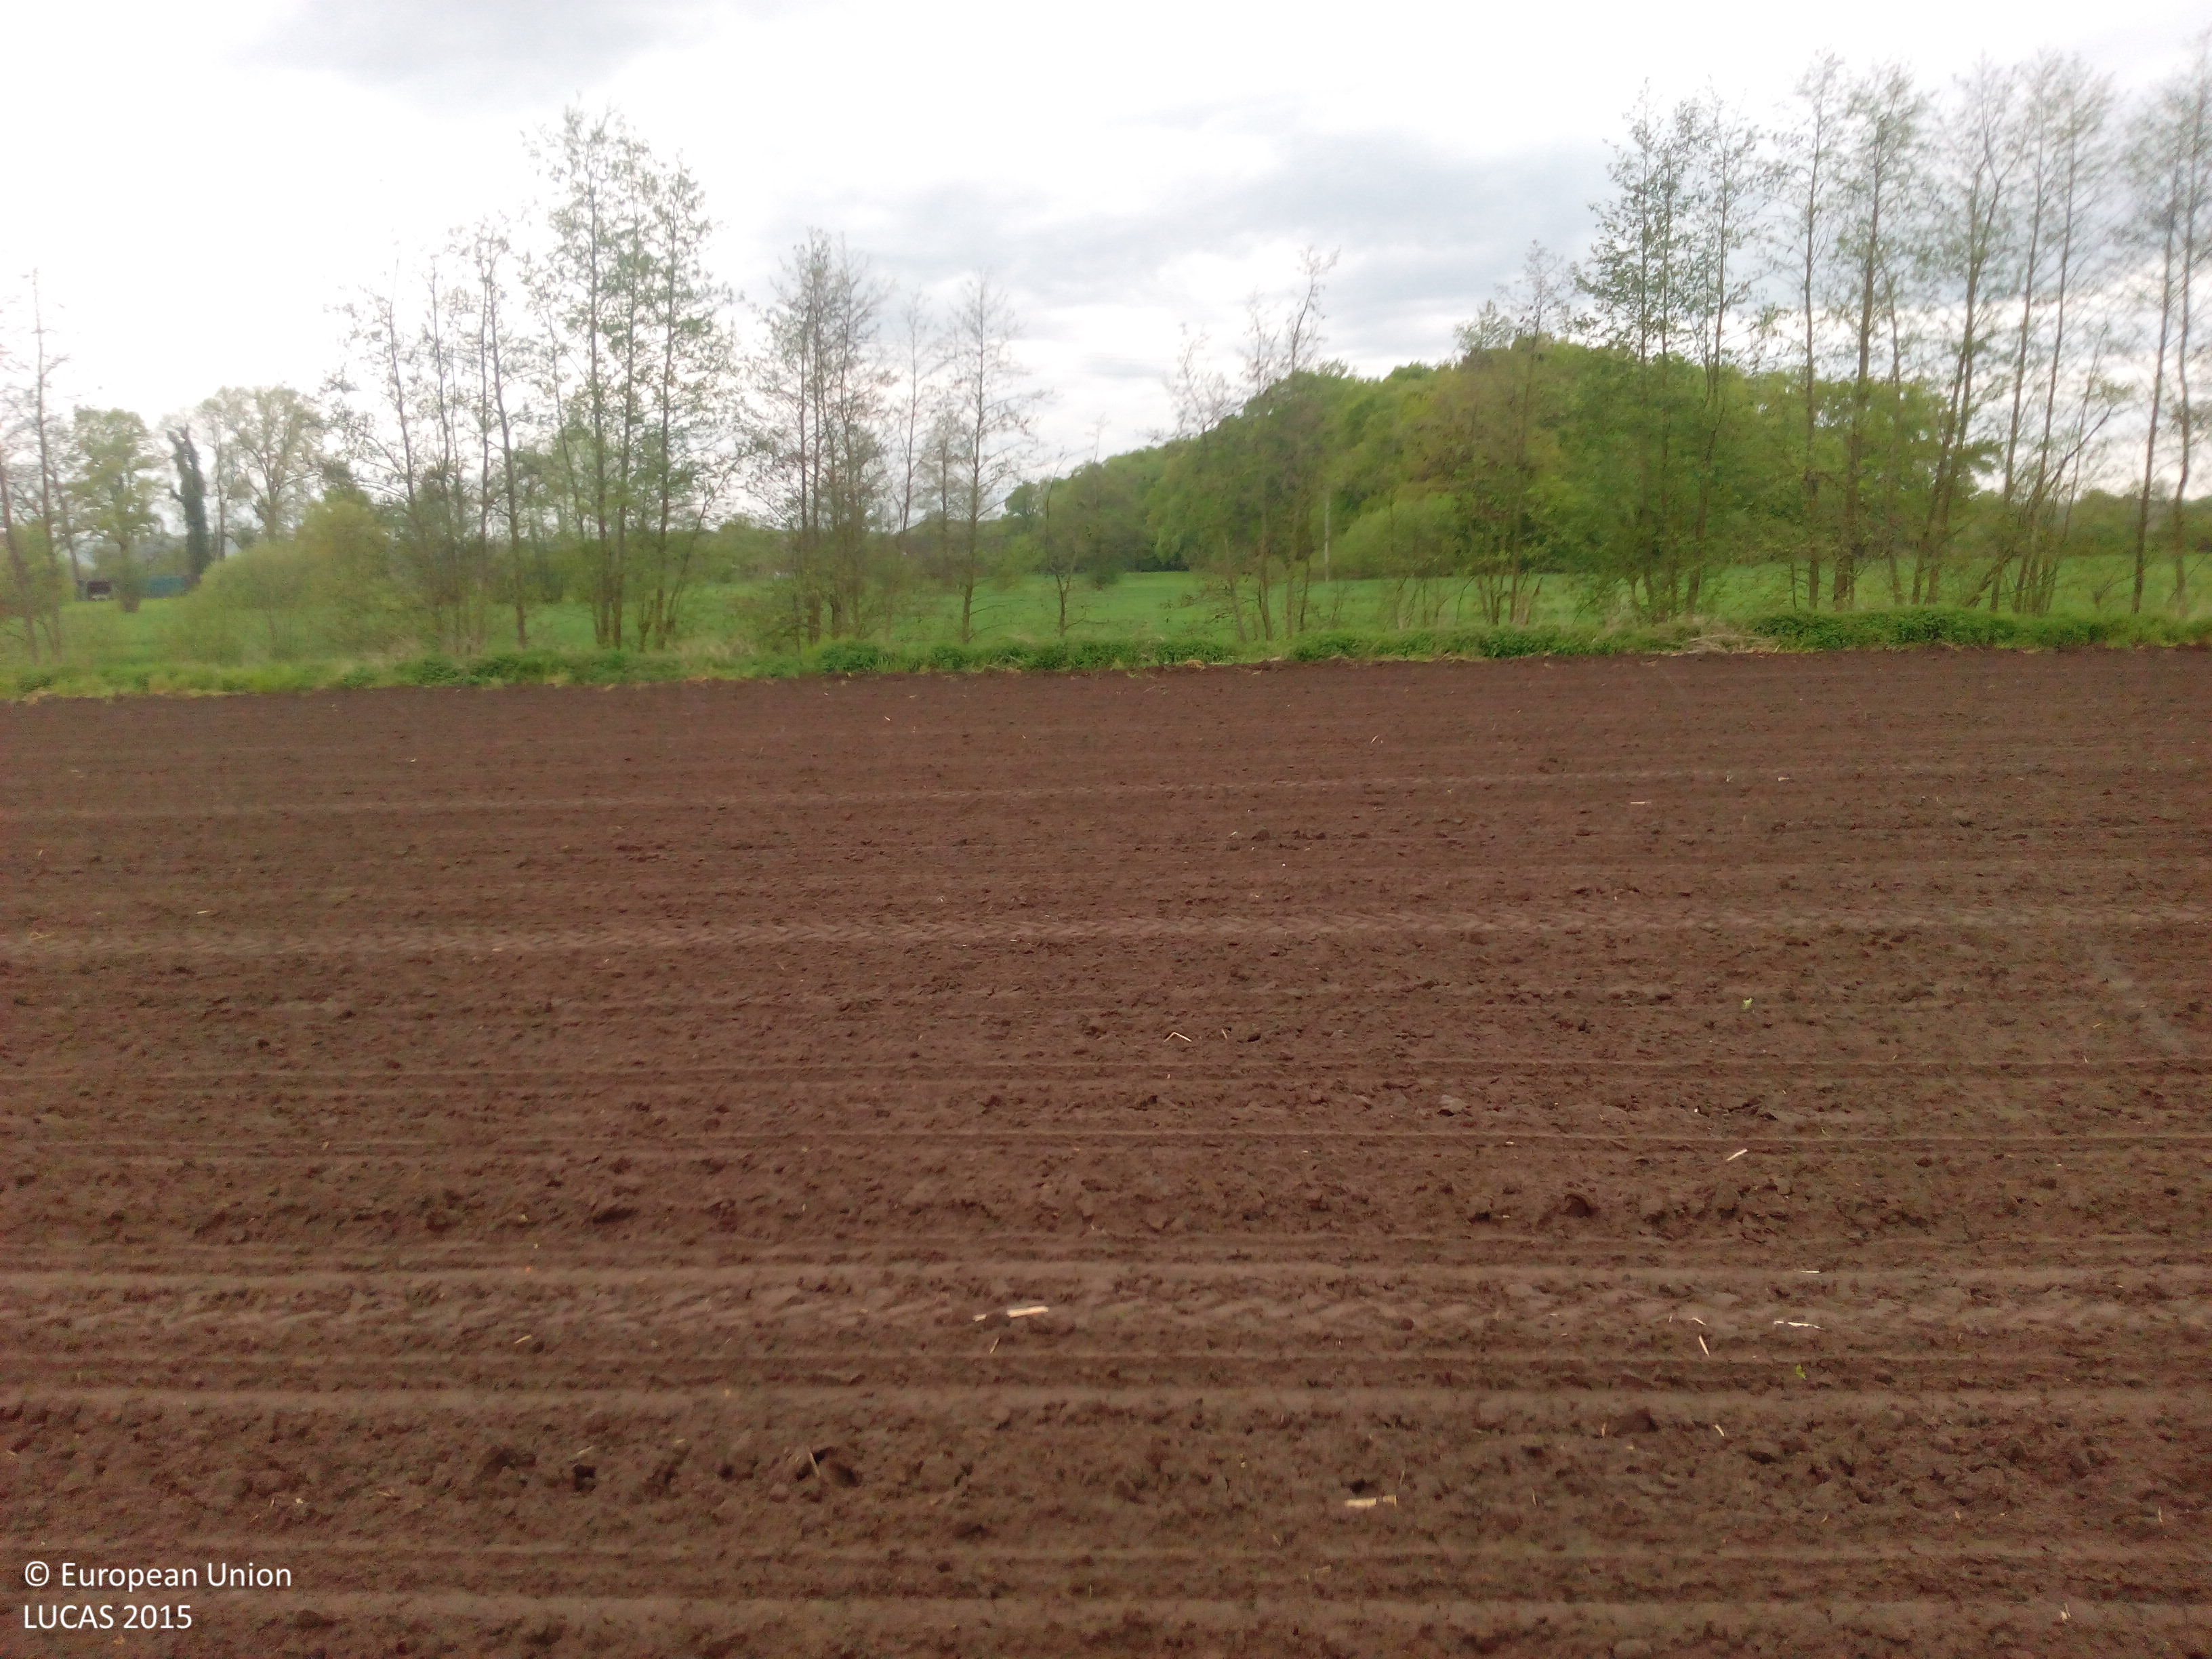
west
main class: Cropland
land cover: Maize
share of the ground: < 10 %
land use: Agriculture (excluding fallow land and kitchen gardens)
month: May
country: DE
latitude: 51.9905
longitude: 7.4518
